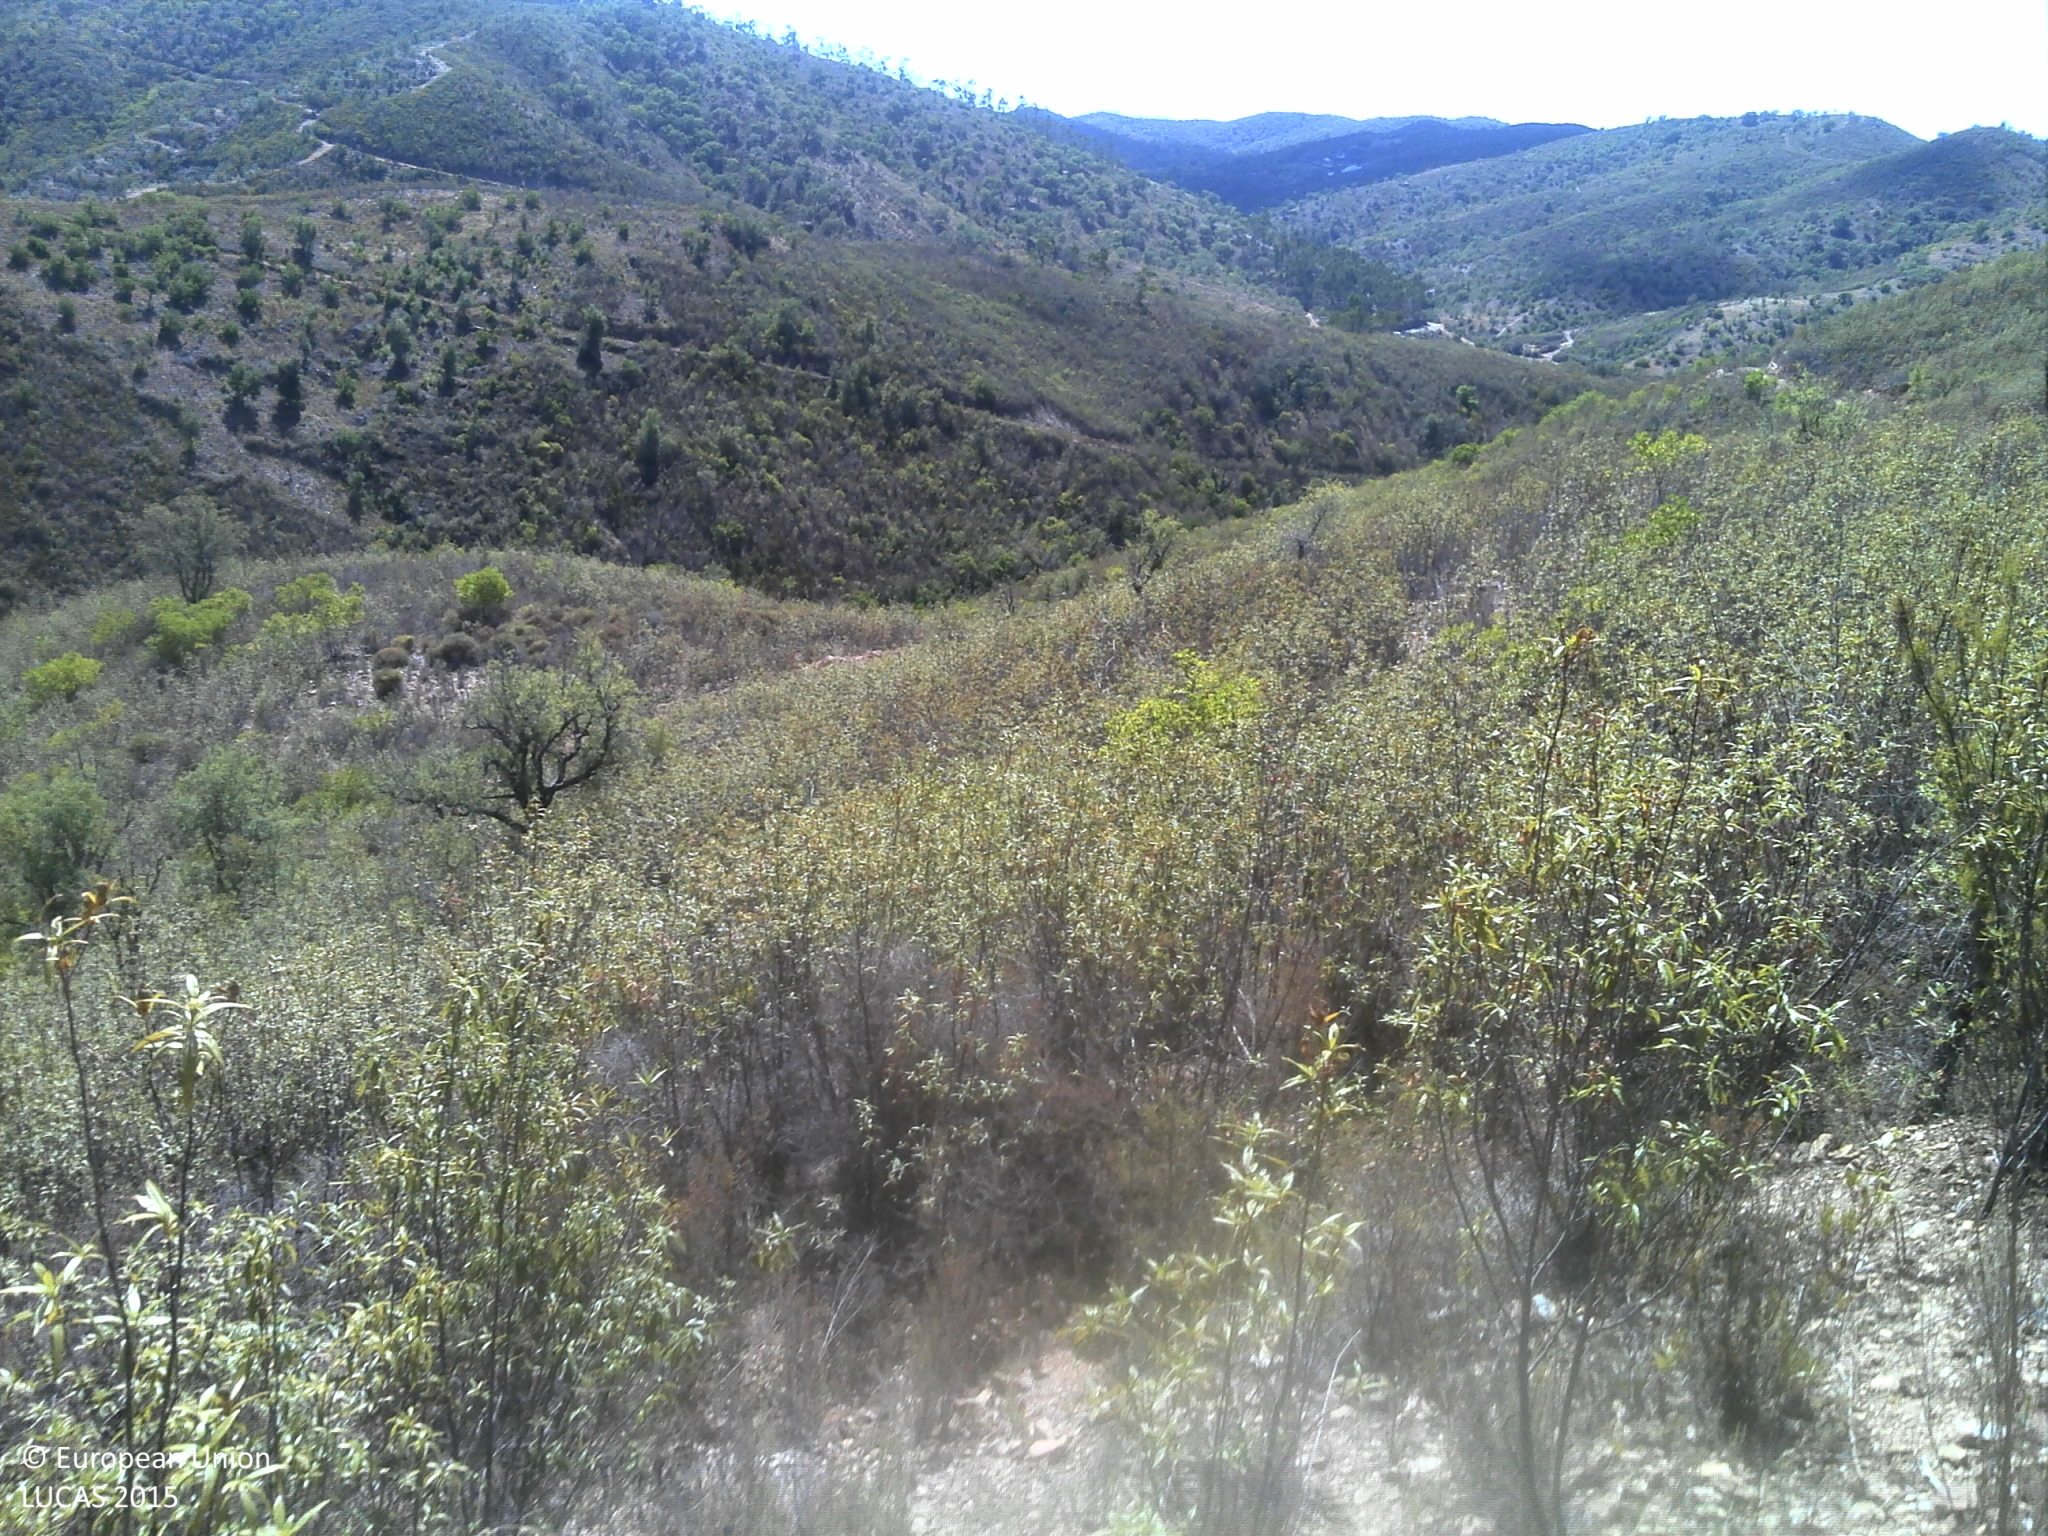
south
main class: Shrubland
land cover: Shrubland with sparse tree cover
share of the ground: 25 - 50 %
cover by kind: shrubs 50 %, unconsolidated bare surface 35 %, herbaceous plants 10 %, broadleaved forest trees 5 %
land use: Semi-natural and natural areas not in use
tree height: < 5 m
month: September
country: PT
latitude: 37.3269
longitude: -8.2025
